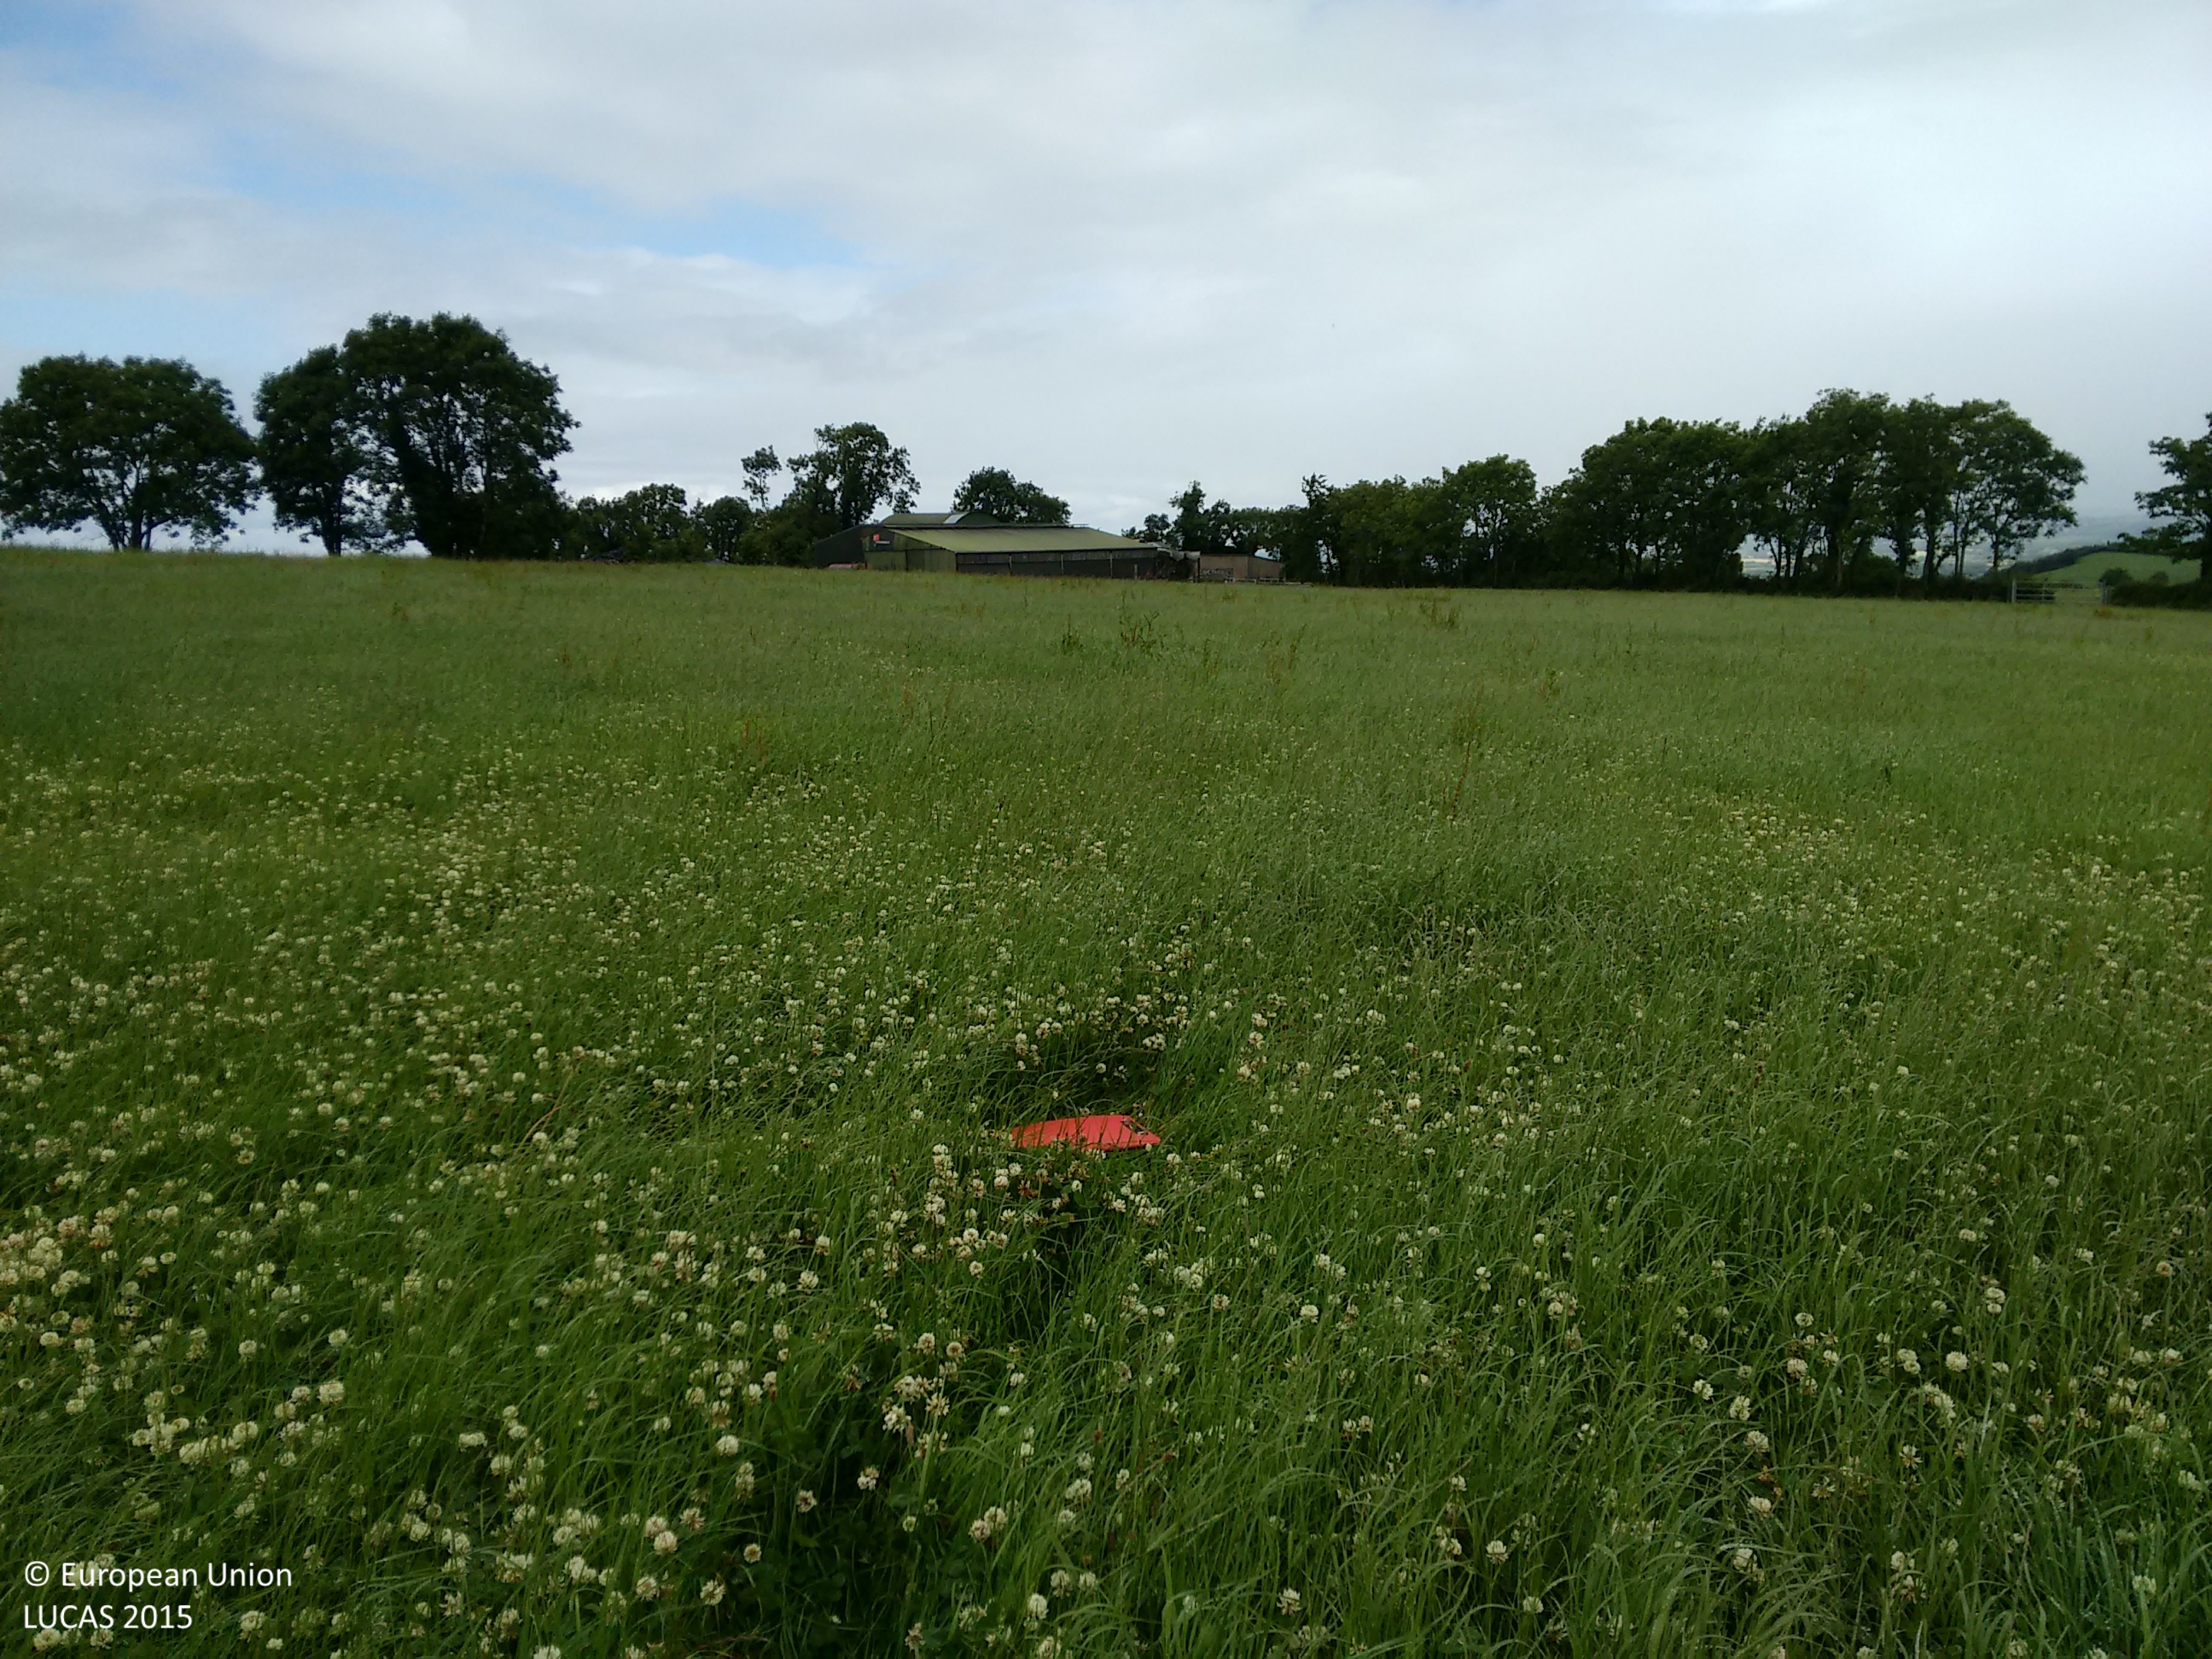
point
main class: Grassland
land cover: Grassland without tree/shrub cover
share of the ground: > 75 %
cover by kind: herbaceous plants 100 %
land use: Agriculture (excluding fallow land and kitchen gardens)
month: July
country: IE
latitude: 52.6863
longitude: -7.3591
